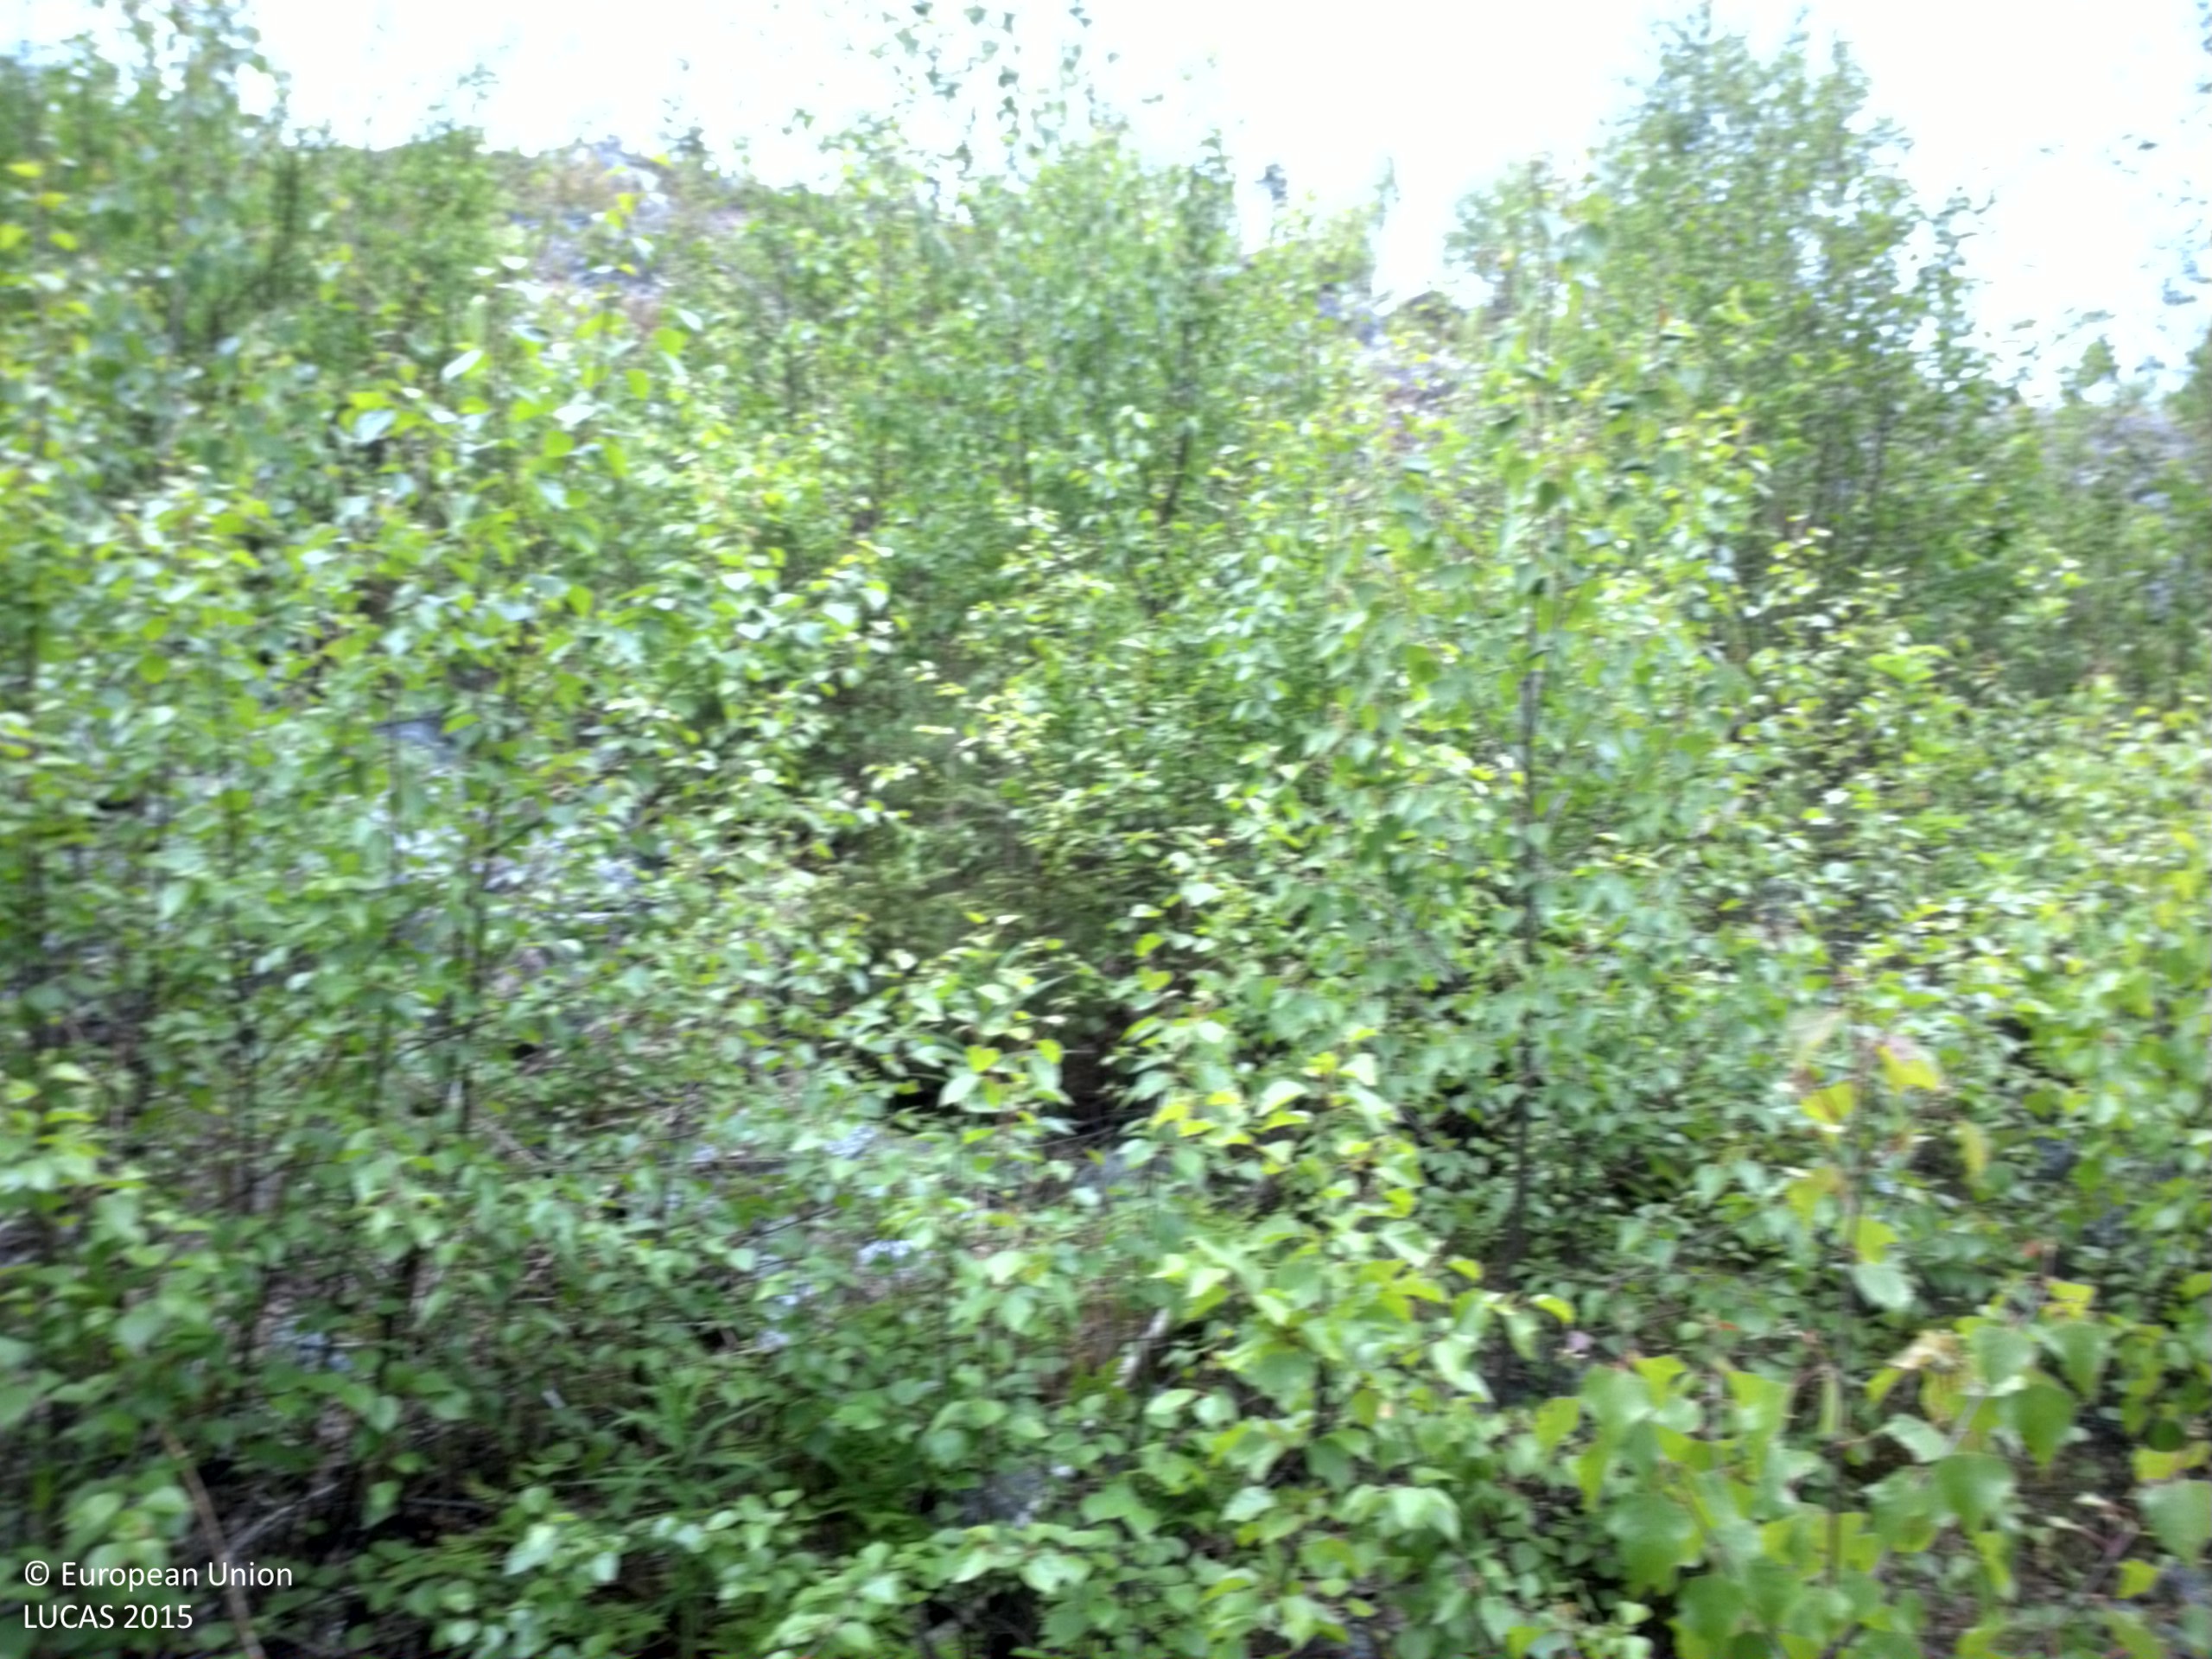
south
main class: Woodland
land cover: Broadleaved woodland
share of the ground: > 75 %
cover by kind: broadleaved forest trees 75 %, shrubs 15 %, coniferous forest trees 5 %, lichens and mosses 5 %
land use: Forestry
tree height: < 5 m
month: June
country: SE
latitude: 63.1707
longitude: 17.8212
